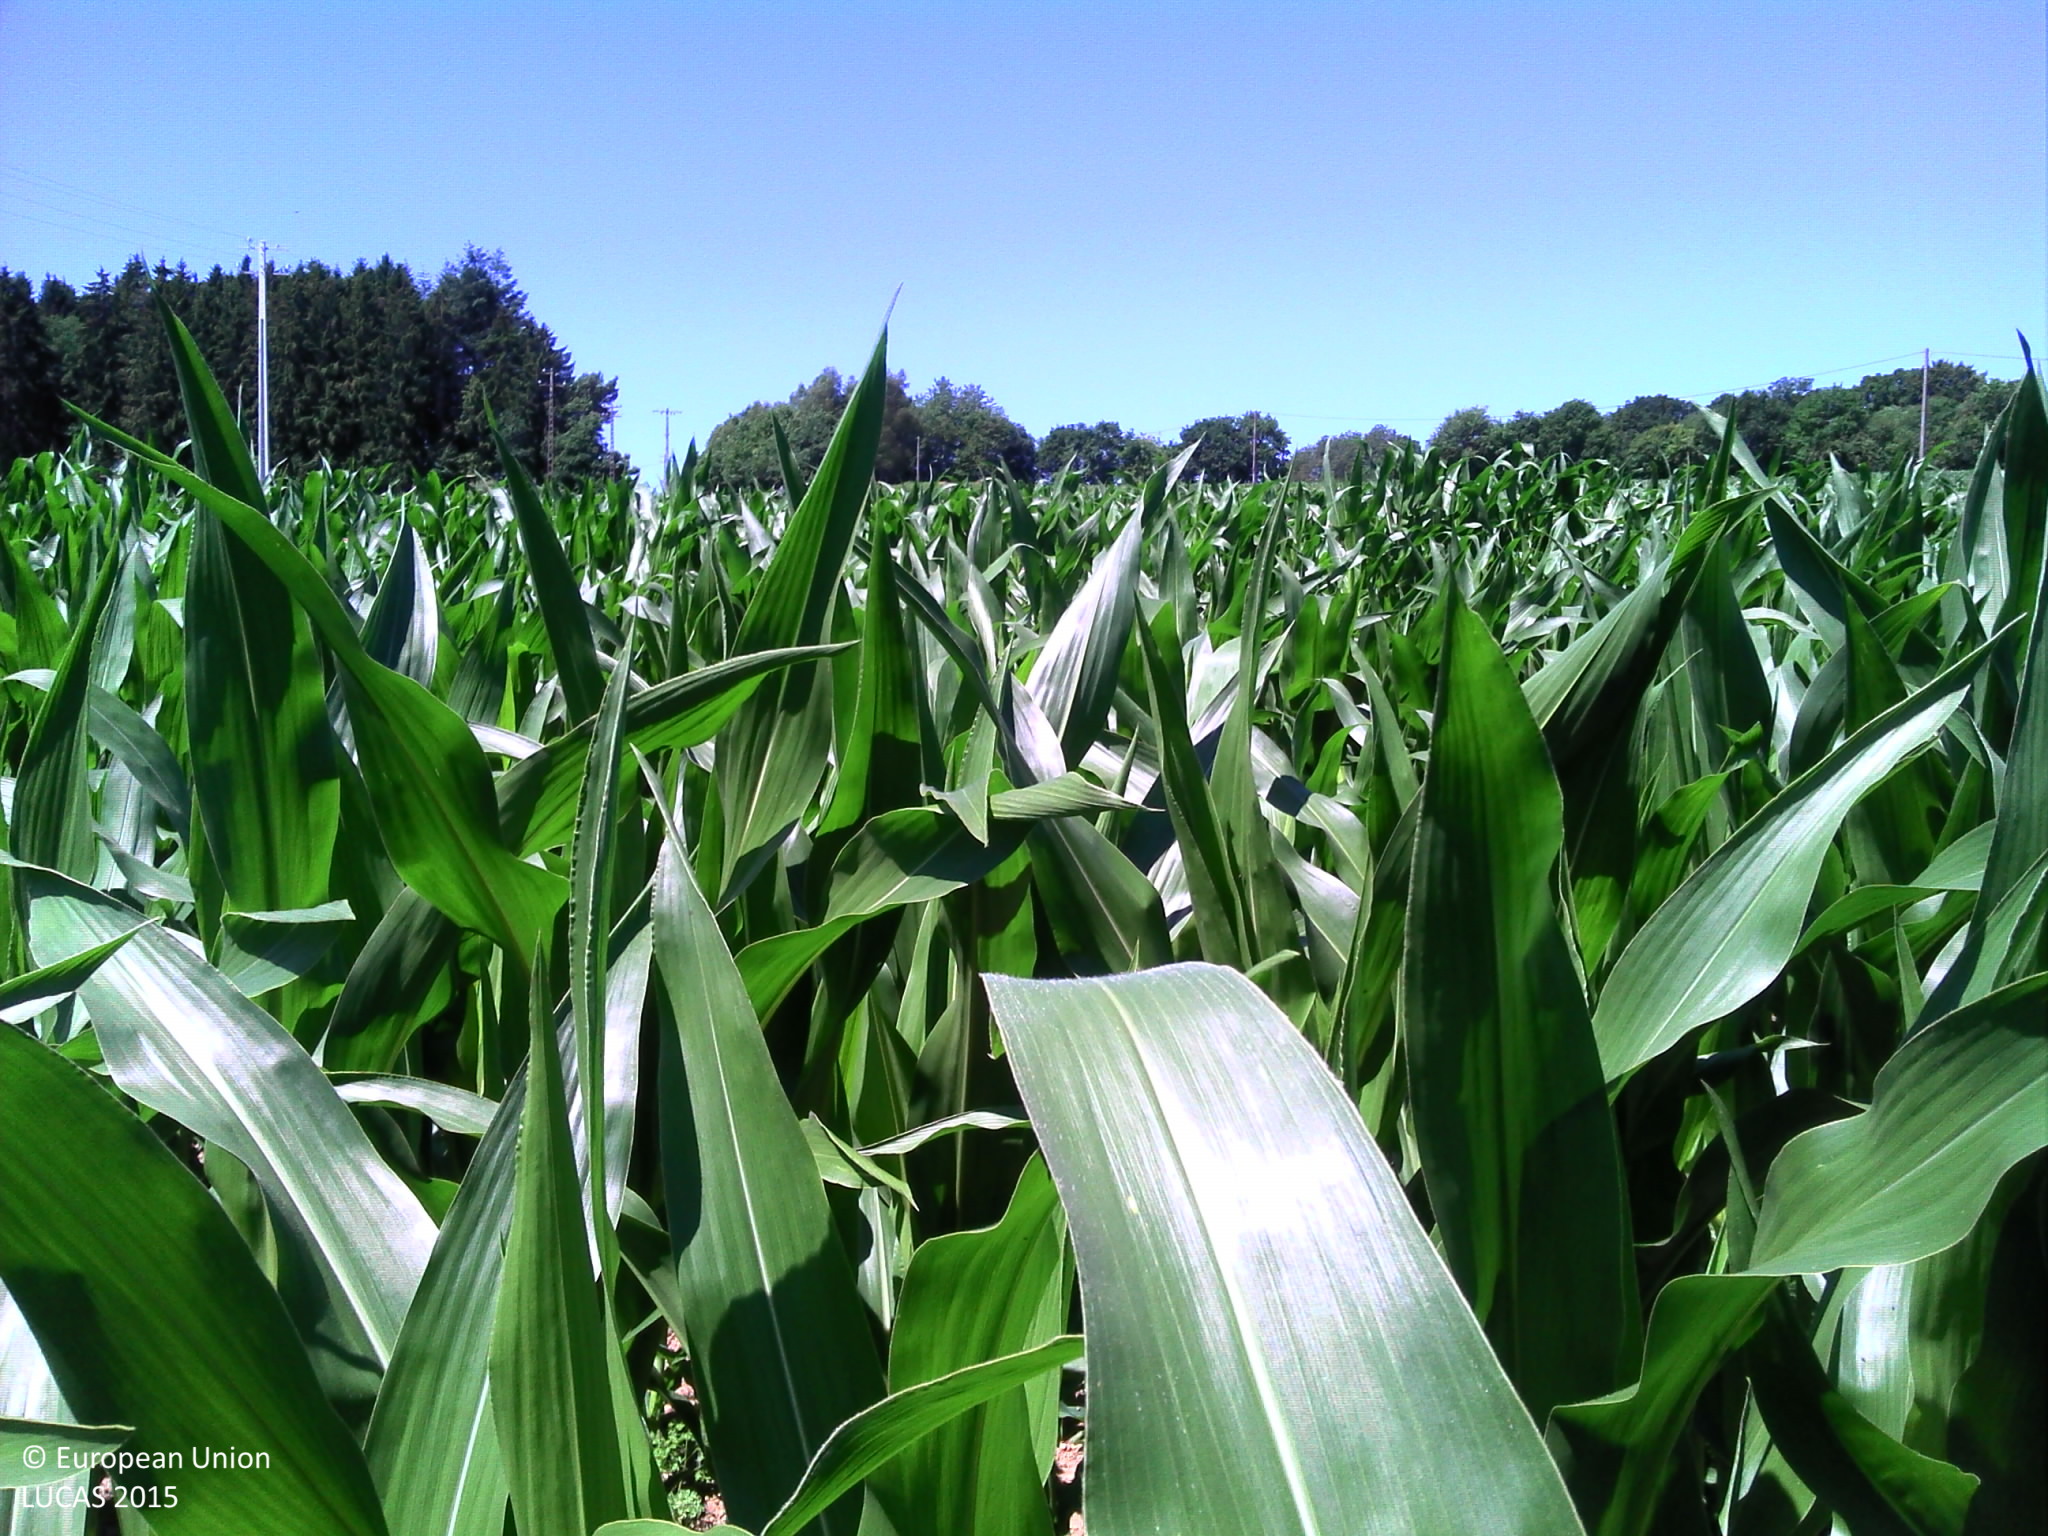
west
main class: Cropland
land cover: Maize
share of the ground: > 75 %
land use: Agriculture (excluding fallow land and kitchen gardens)
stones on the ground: < 10 %
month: July
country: BE
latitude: 50.1160
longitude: 5.5652
